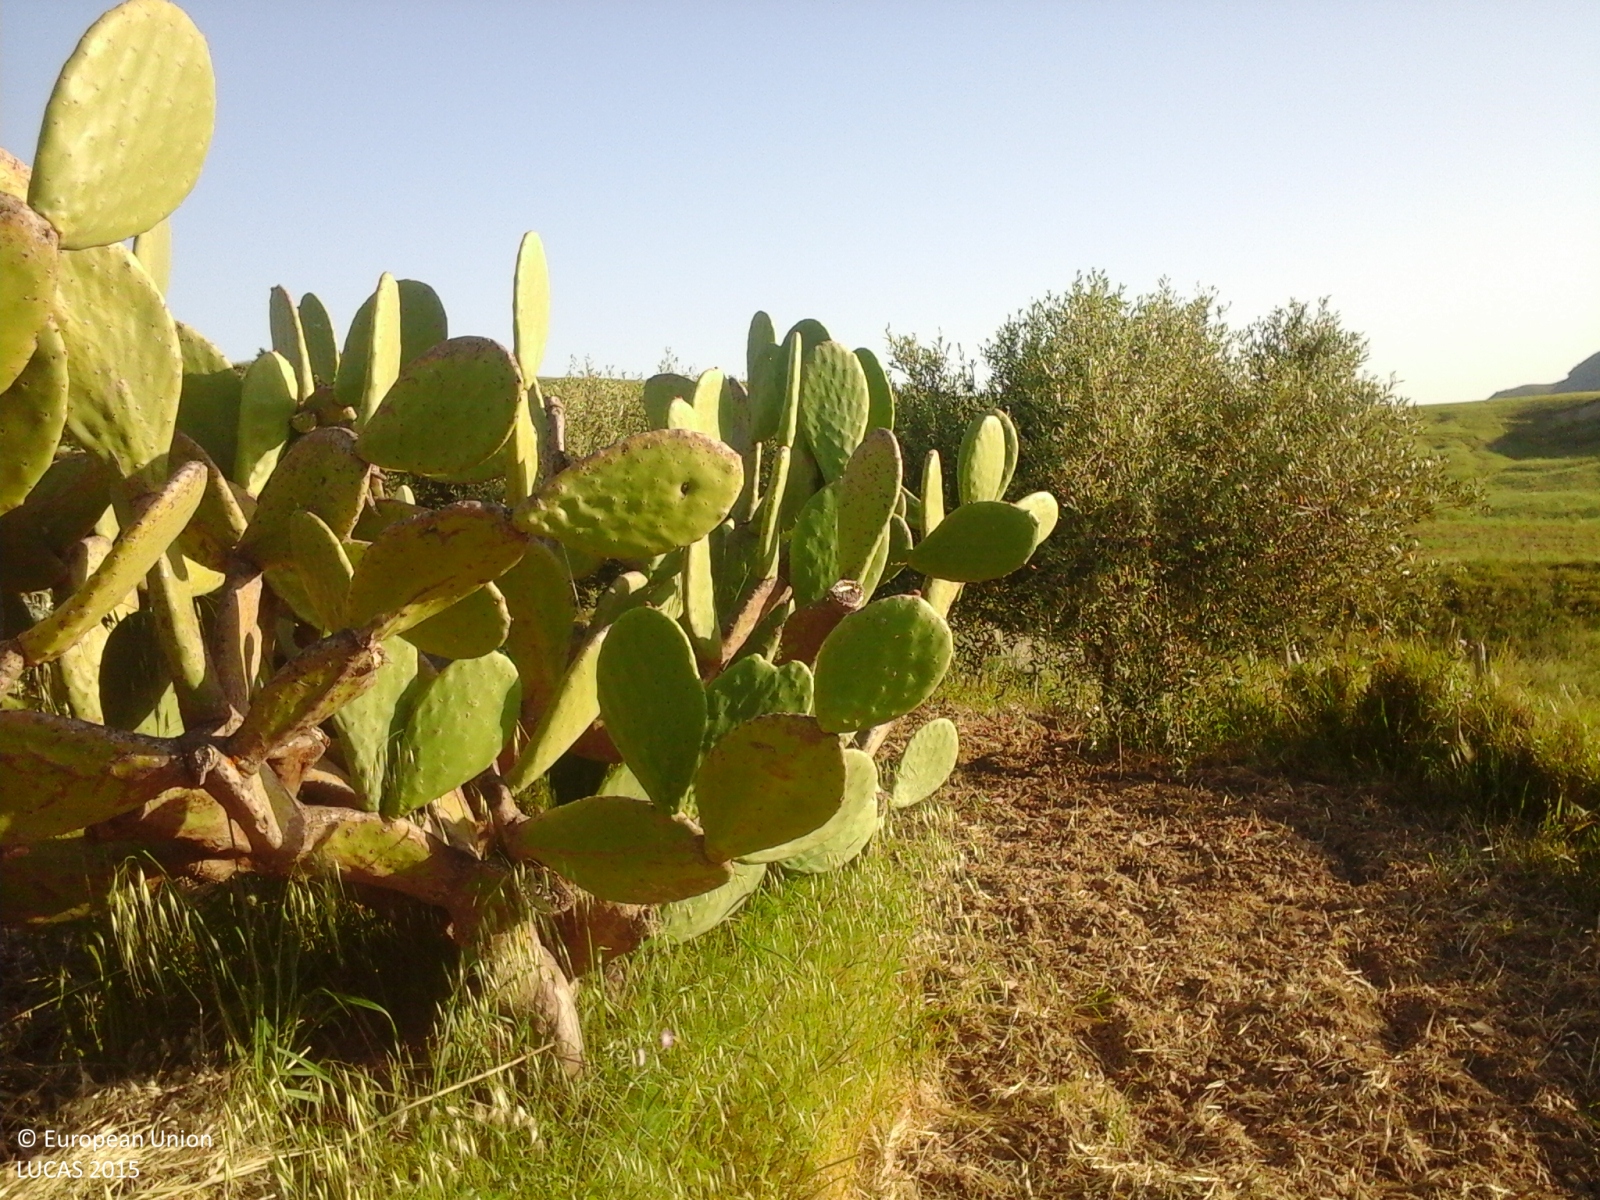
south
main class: Grassland
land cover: Grassland without tree/shrub cover
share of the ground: > 75 %
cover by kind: herbaceous plants 100 %
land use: Agriculture (excluding fallow land and kitchen gardens)
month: May
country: IT
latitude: 37.5461
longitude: 14.1908
